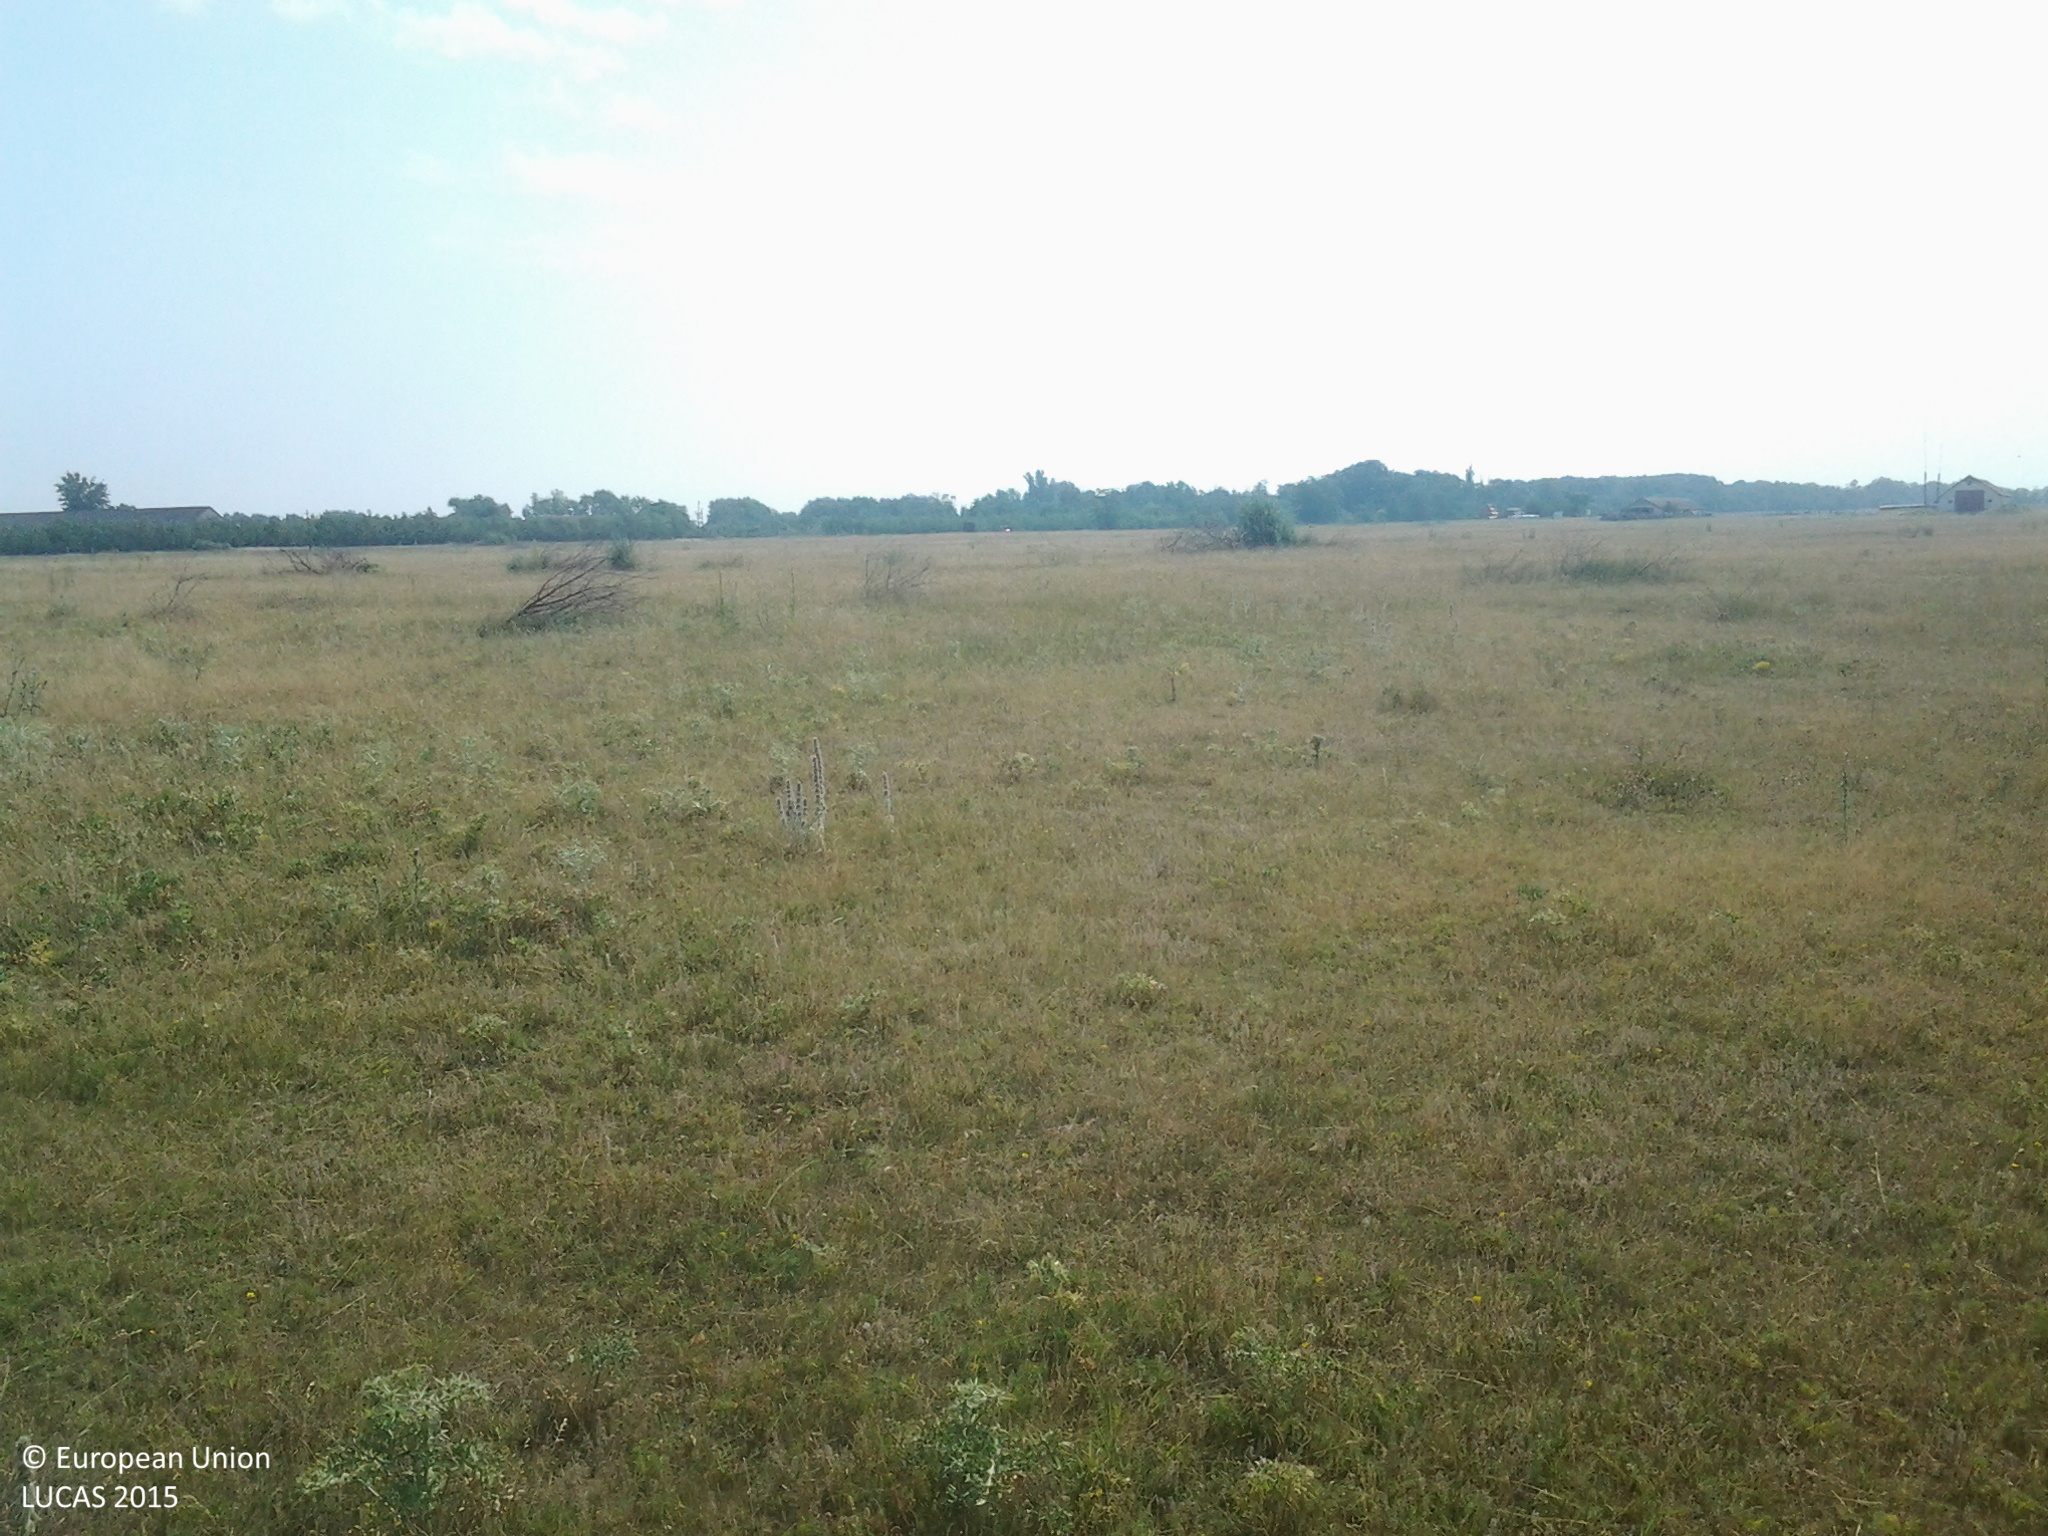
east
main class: Grassland
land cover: Grassland without tree/shrub cover
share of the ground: > 75 %
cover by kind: herbaceous plants 100 %
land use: Agriculture (excluding fallow land and kitchen gardens)
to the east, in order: Grassland without tree/shrub cover; Grassland with sparse tree/shrub cover; Grassland without tree/shrub cover
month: July
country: HU
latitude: 47.0063
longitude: 19.1844
